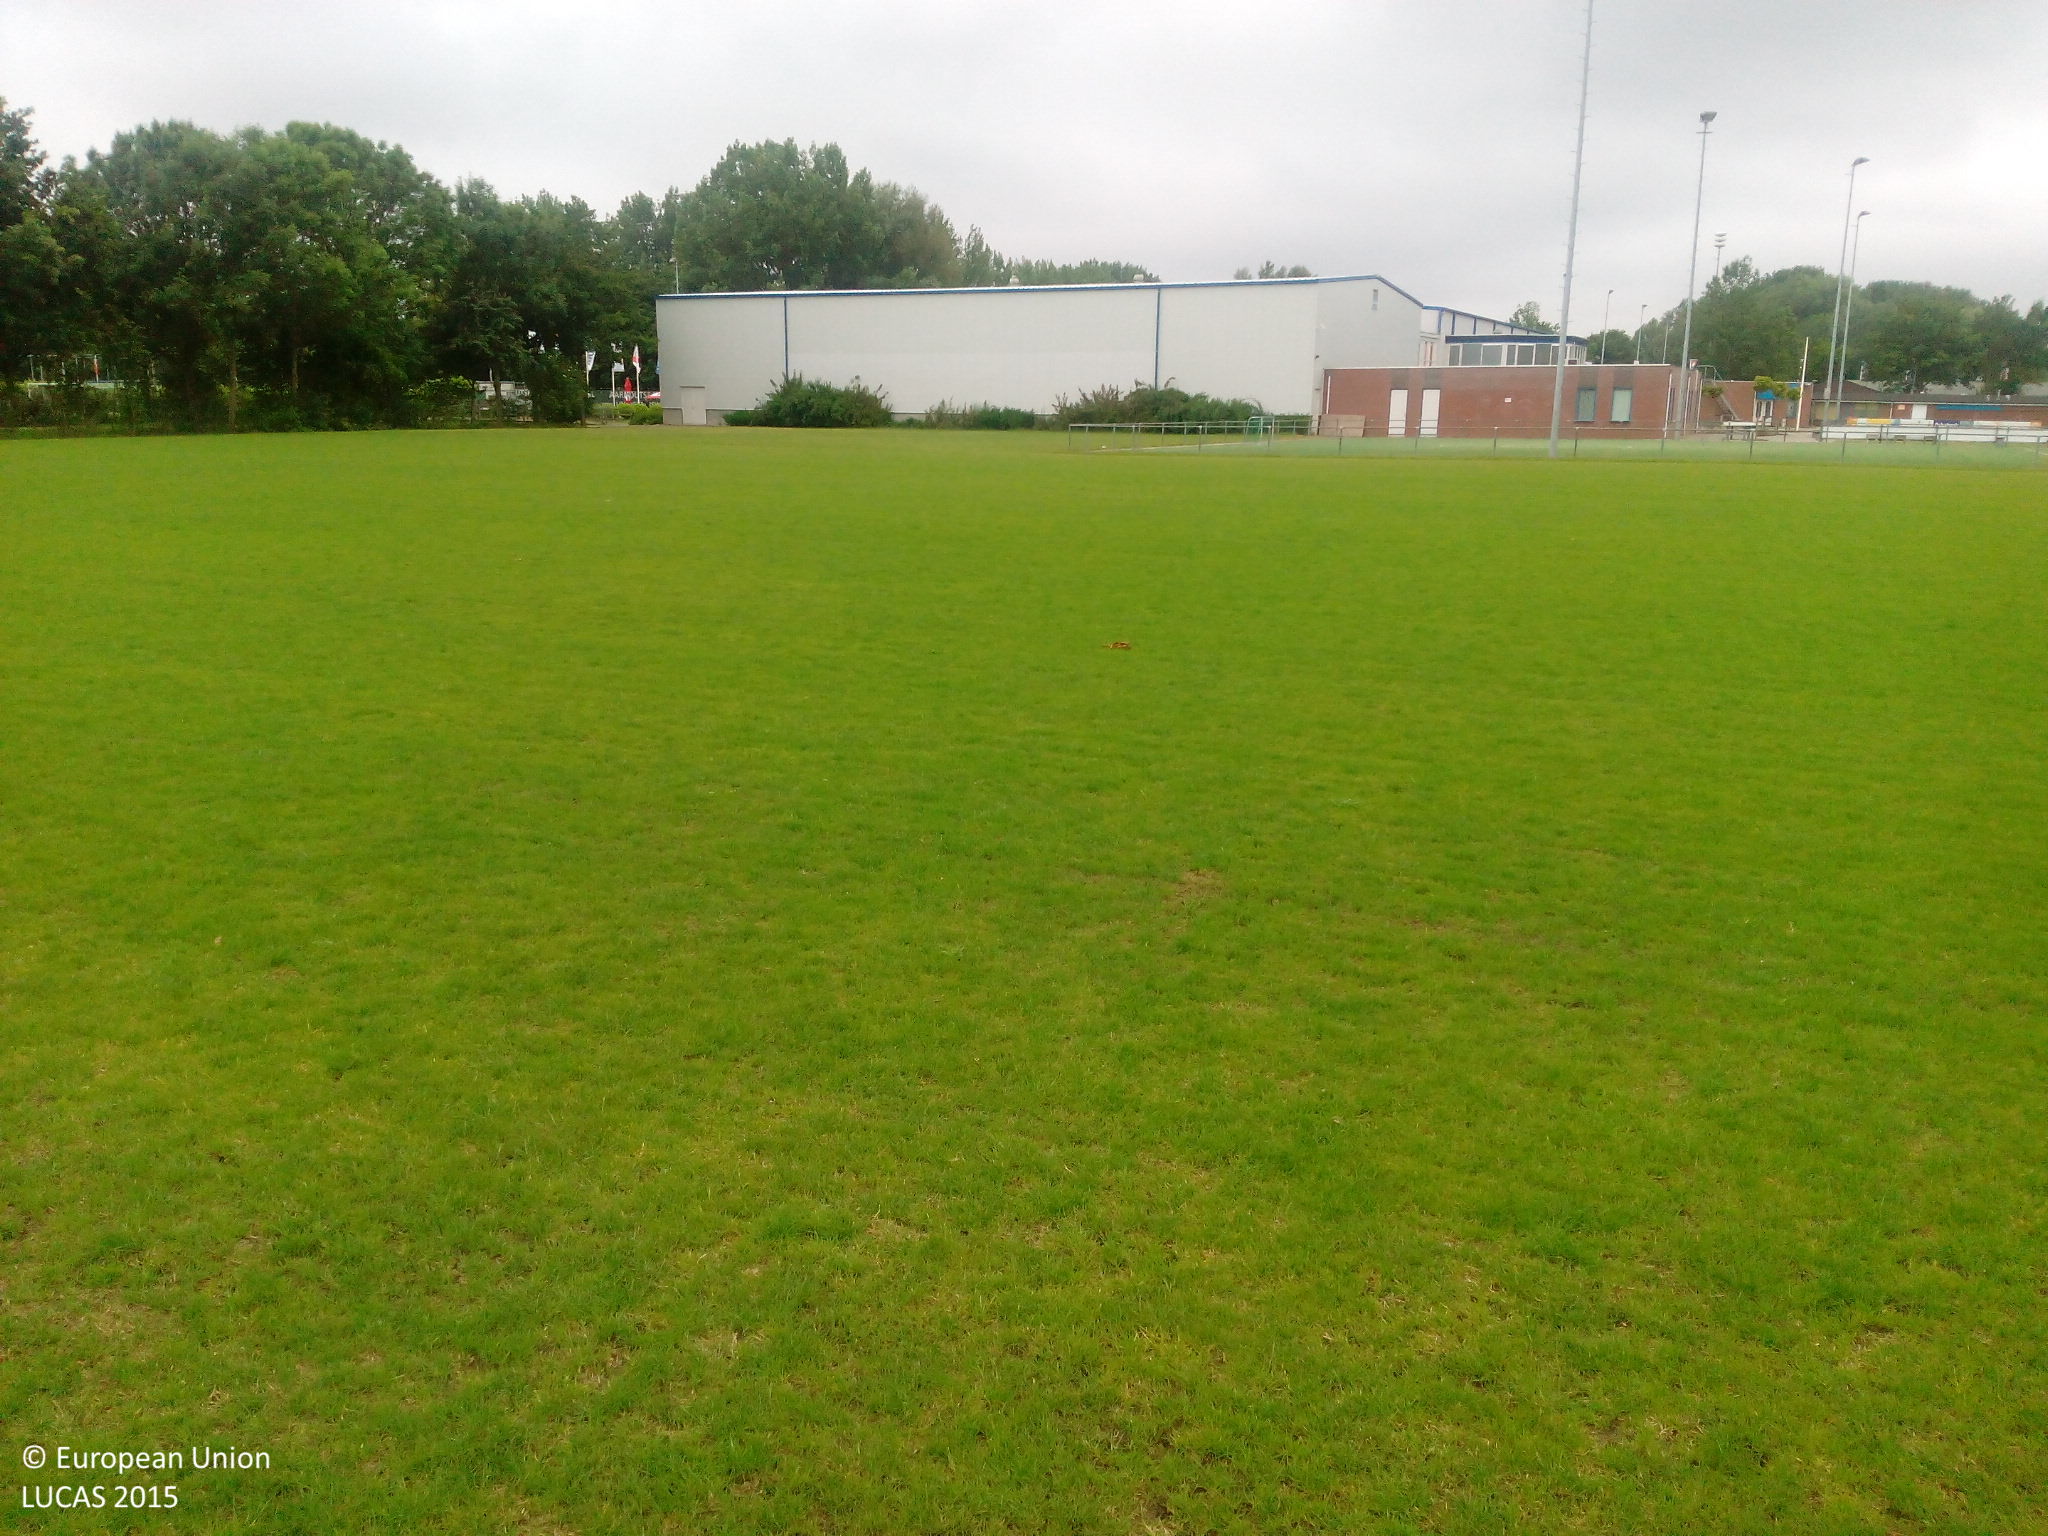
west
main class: Grassland
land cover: Grassland without tree/shrub cover
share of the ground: > 75 %
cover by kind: herbaceous plants 100 %
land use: Sport
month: June
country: NL
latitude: 51.8089
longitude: 4.7025
